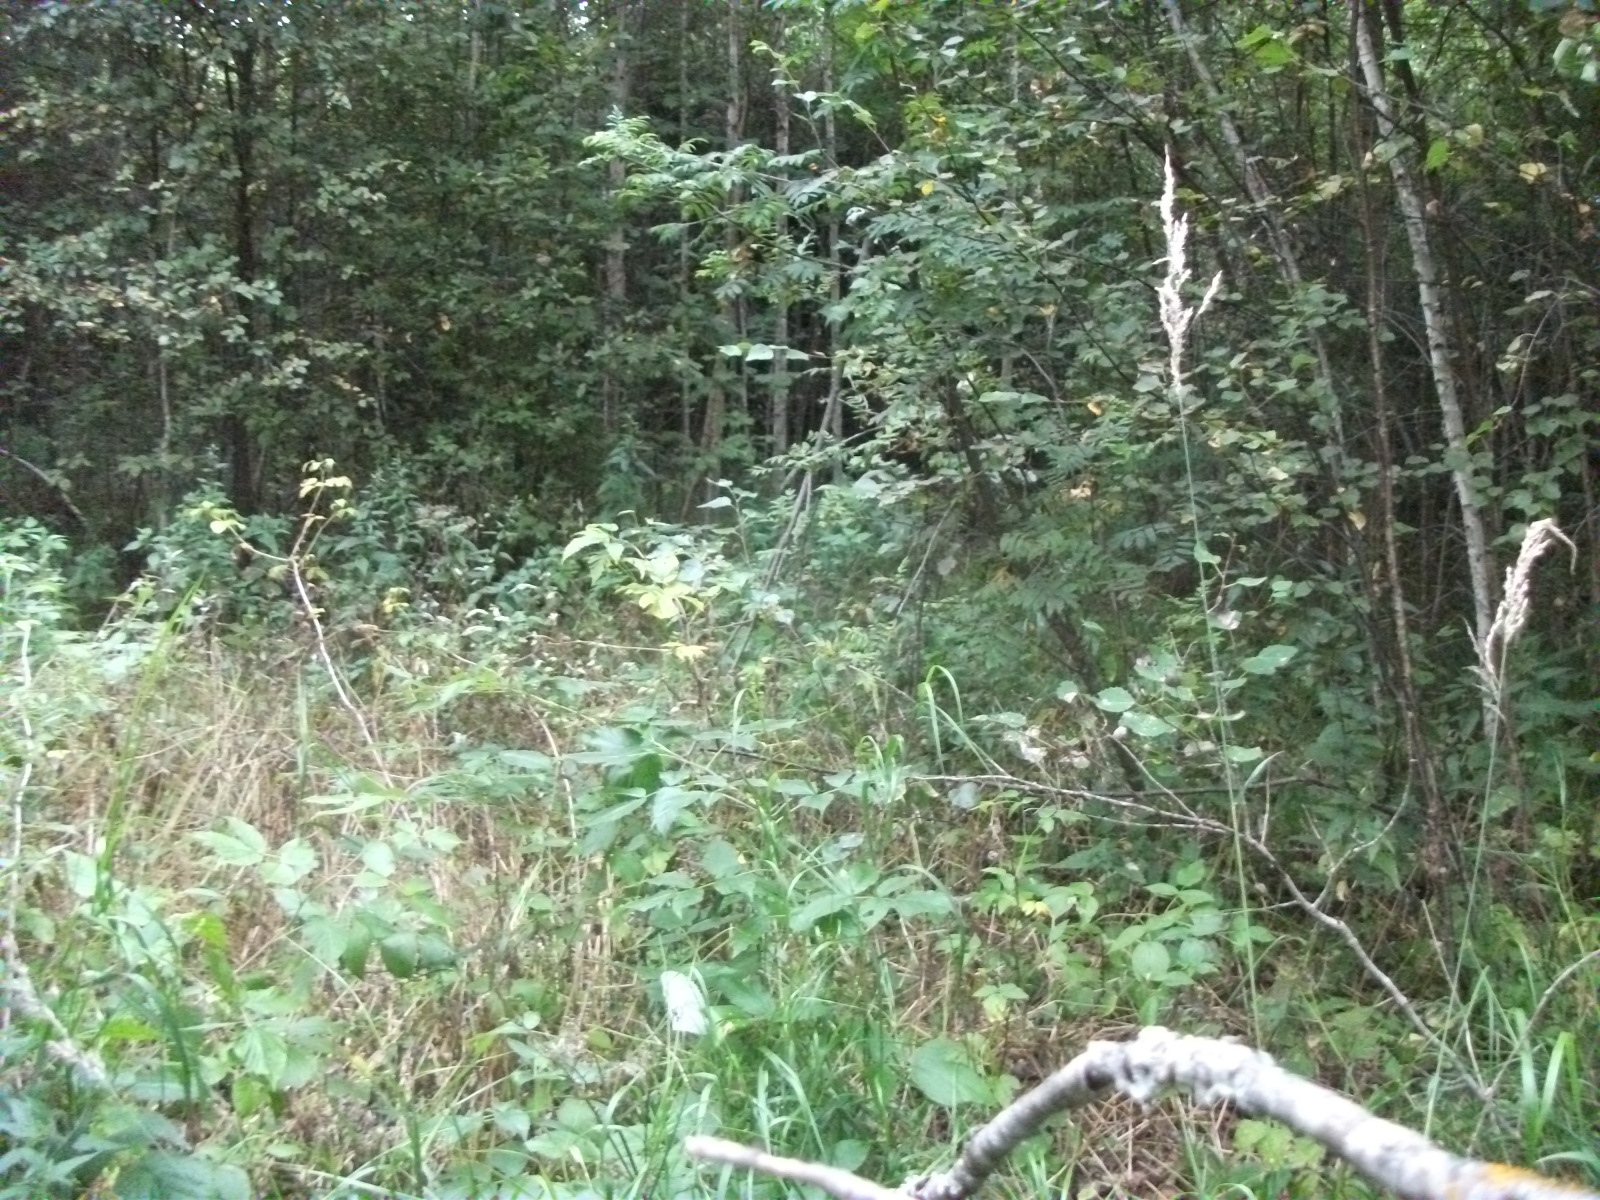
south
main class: Woodland
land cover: Broadleaved woodland
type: non-riverine alder, birch or aspen forest
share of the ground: 50 - 75 %
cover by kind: broadleaved forest trees 60 %, herbaceous plants 35 %, shrubs 5 %
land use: Forestry
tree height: > 5 m
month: August
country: LV
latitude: 56.3089
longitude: 26.3238
